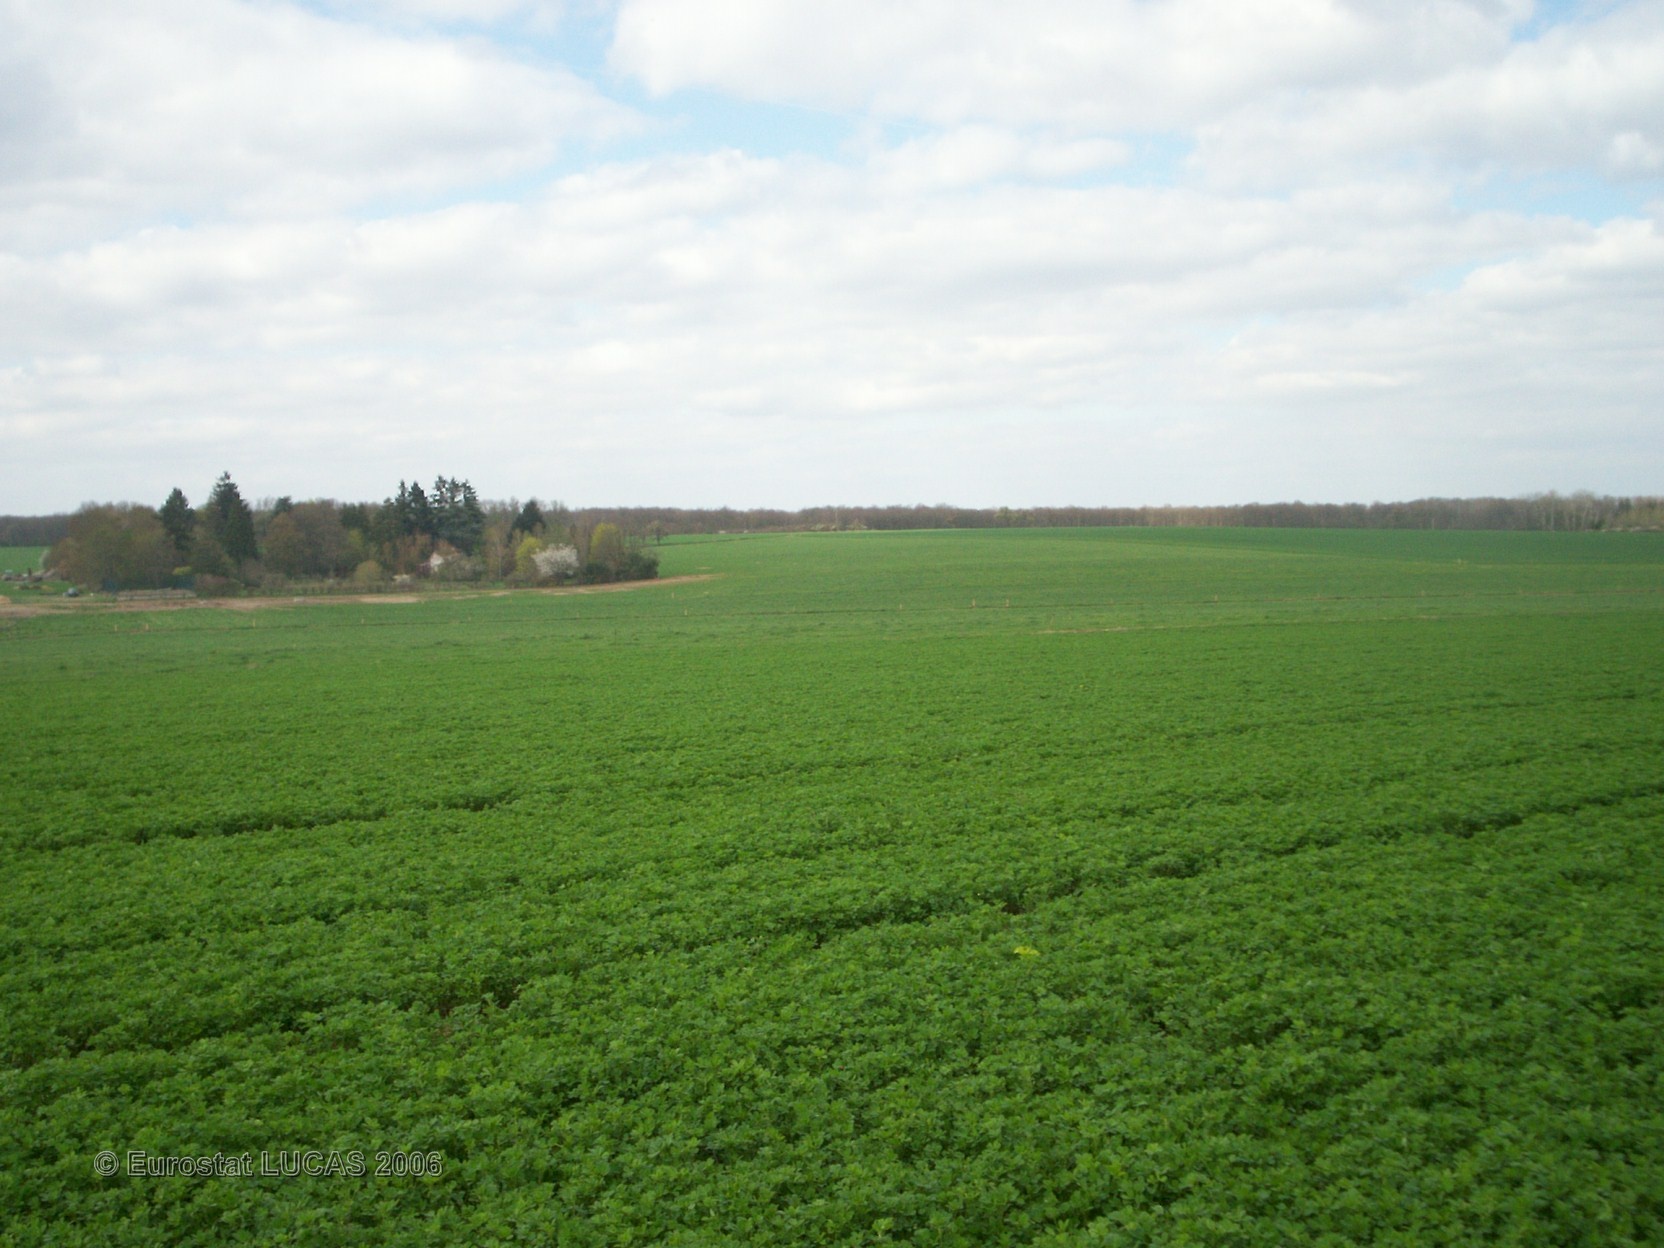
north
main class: Cropland
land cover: Lucerne
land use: Agriculture (excluding fallow land and kitchen gardens)
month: April
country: FR
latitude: 48.4474
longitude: 2.9208
